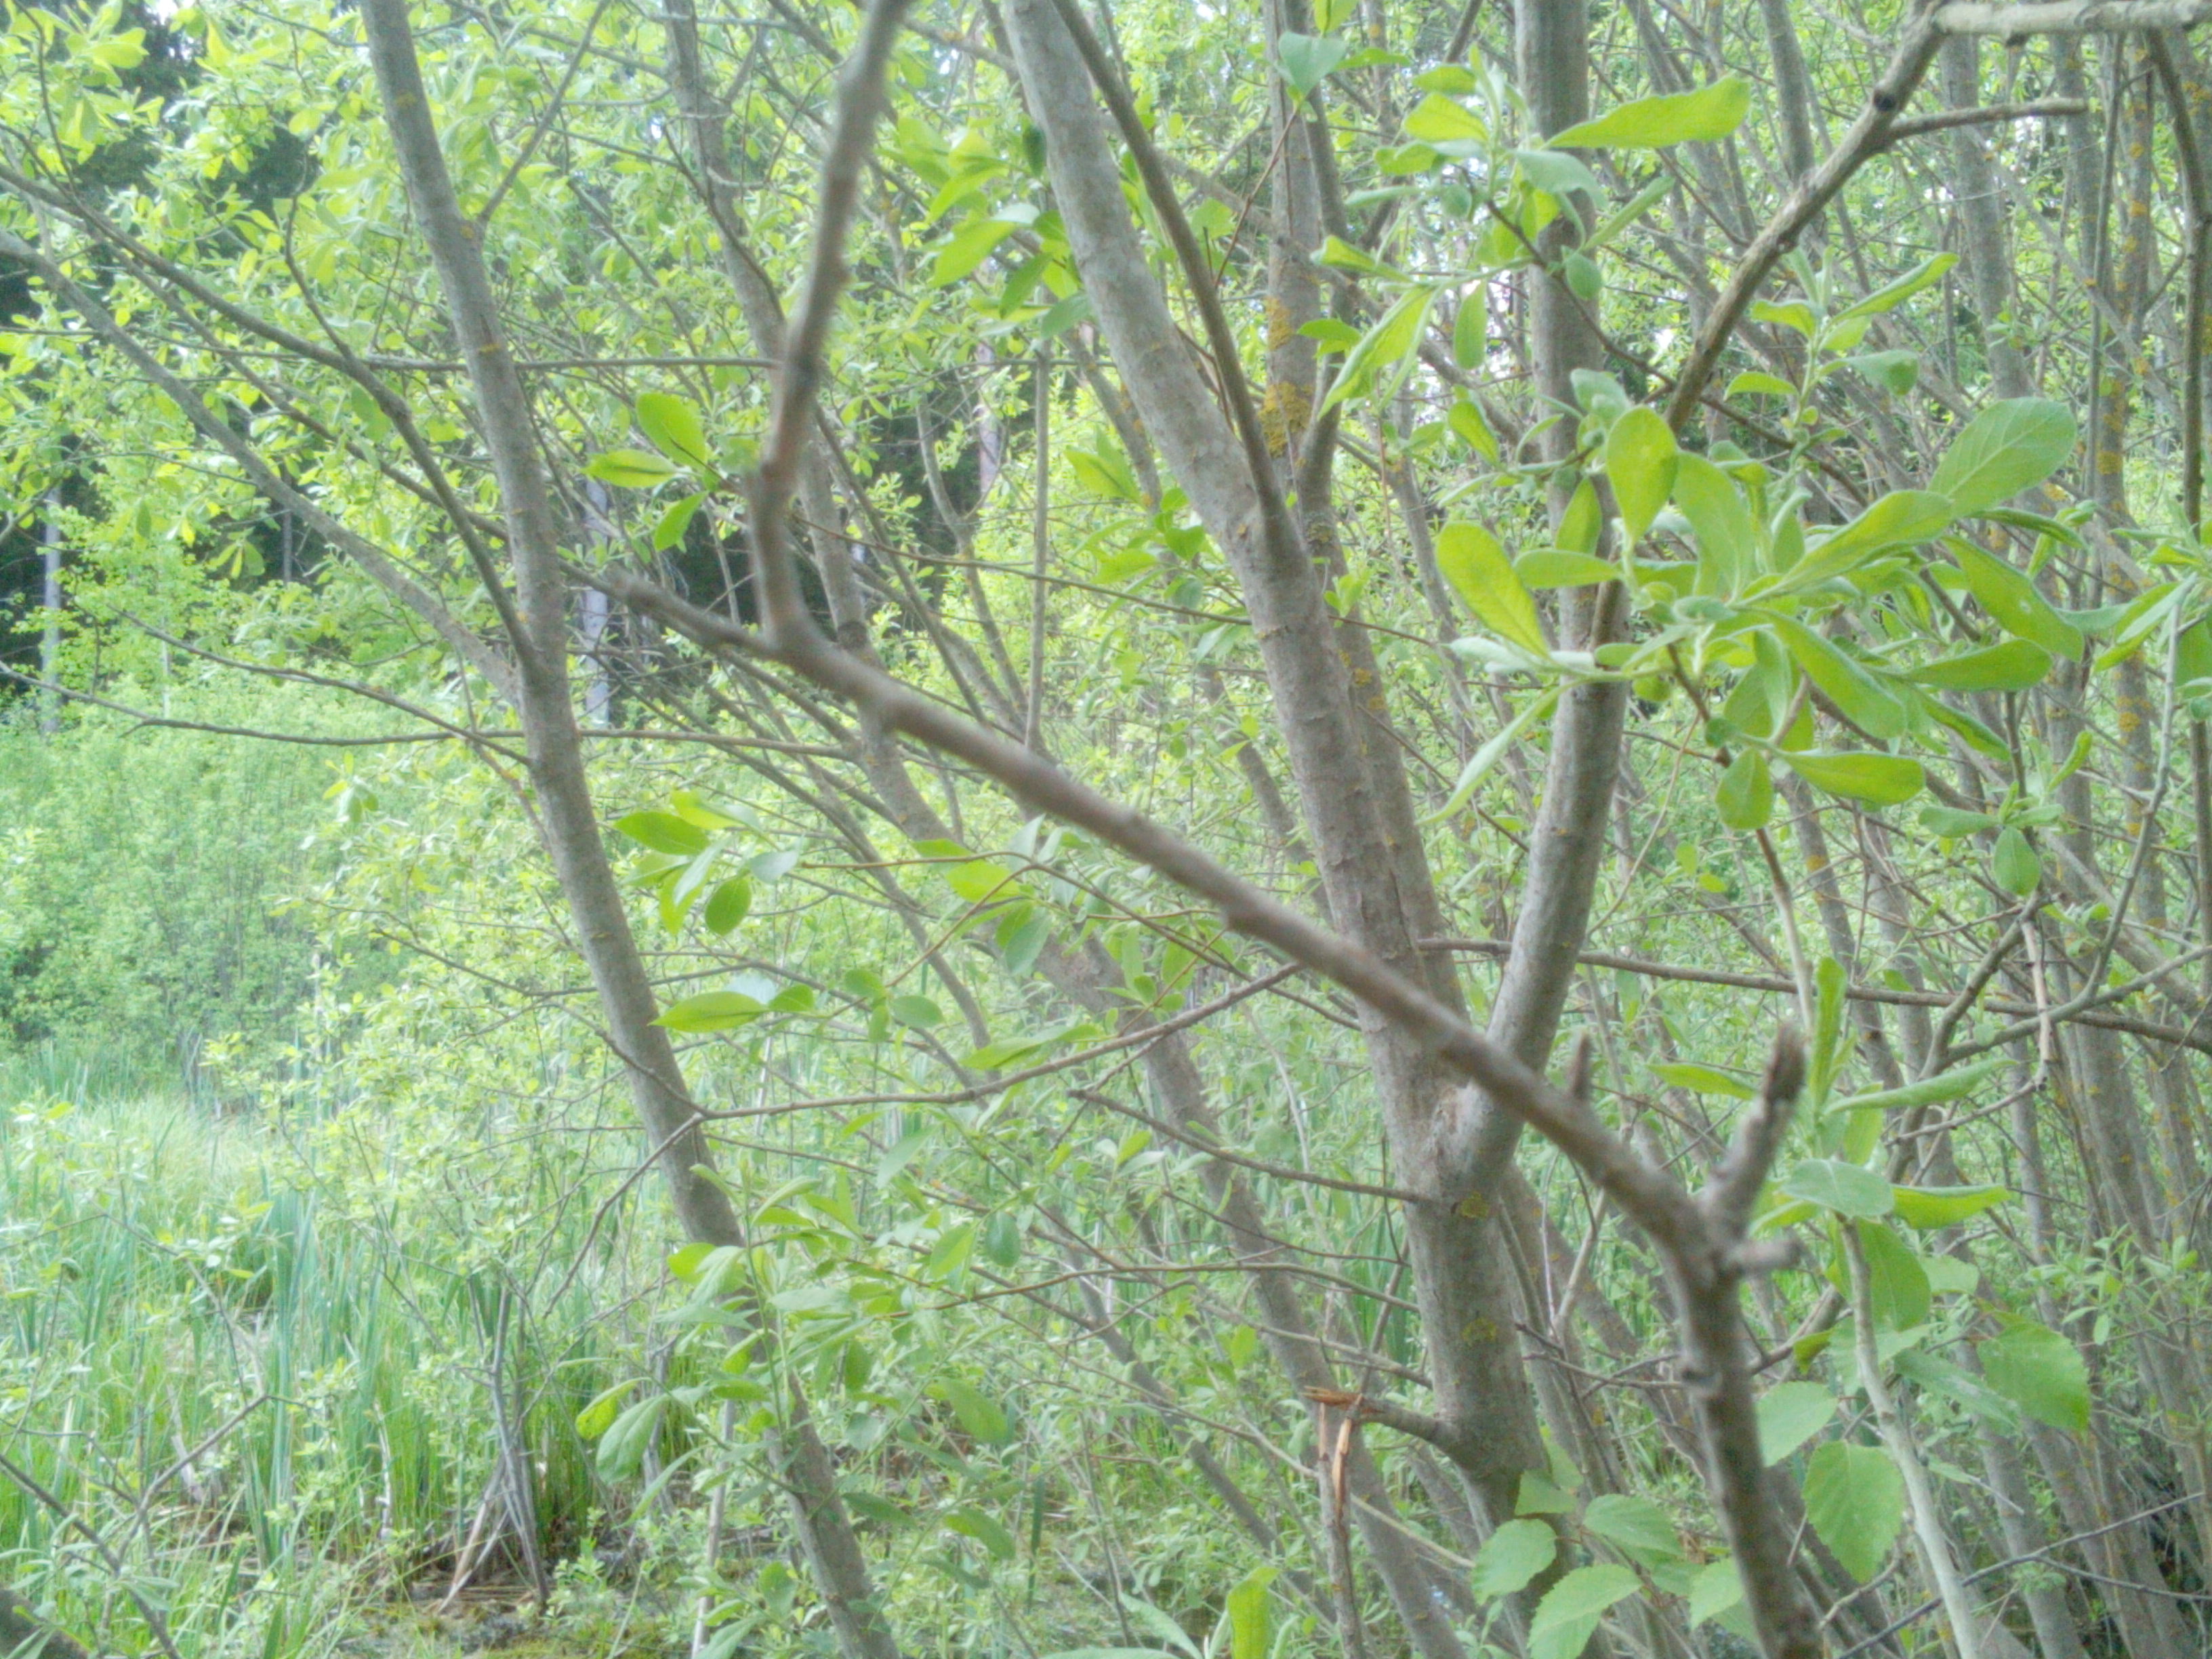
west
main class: Shrubland
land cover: Shrubland without tree cover
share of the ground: > 75 %
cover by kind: shrubs 80 %, herbaceous plants 20 %
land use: Forestry
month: May
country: LV
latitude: 56.5196
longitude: 22.3259
